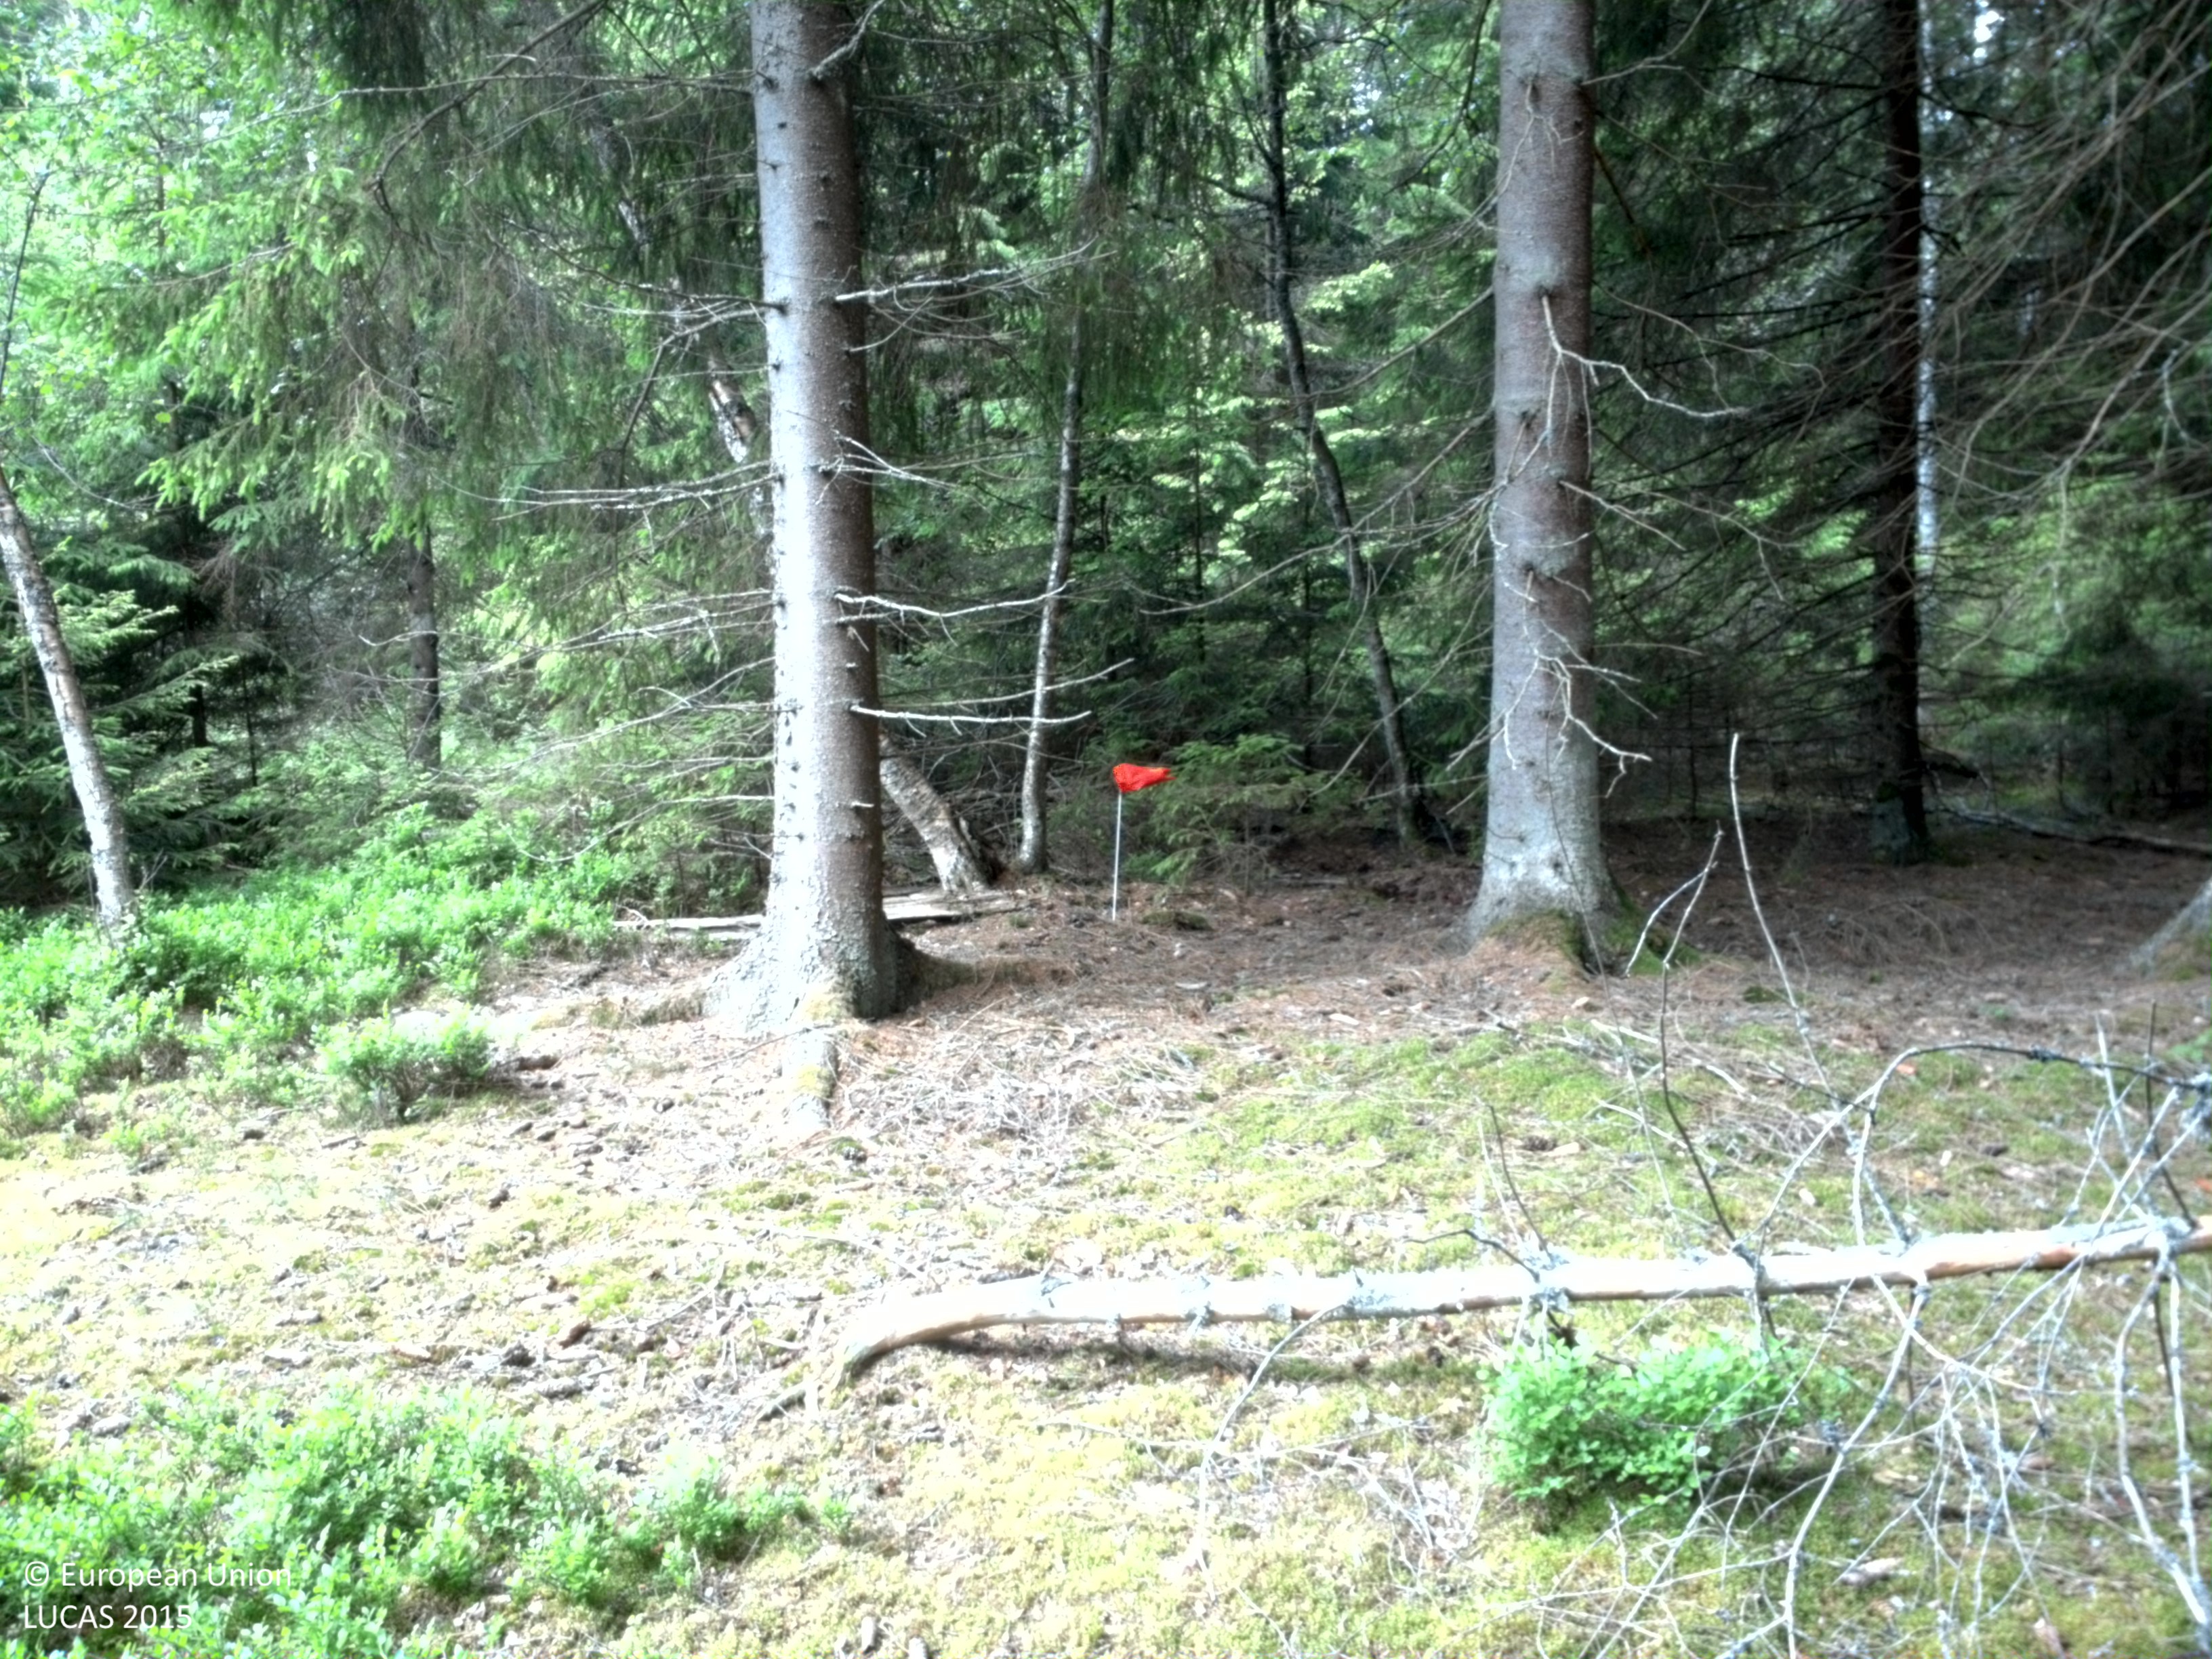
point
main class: Woodland
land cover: Spruce dominated coniferous woodland
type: boreal forest
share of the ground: 25 - 50 %
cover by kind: coniferous forest trees 50 %, lichens and mosses 20 %, consolidated bare surface 20 %, herbaceous plants 10 %
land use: Forestry
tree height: > 5 m
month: June
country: SE
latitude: 58.5754
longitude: 15.5139
